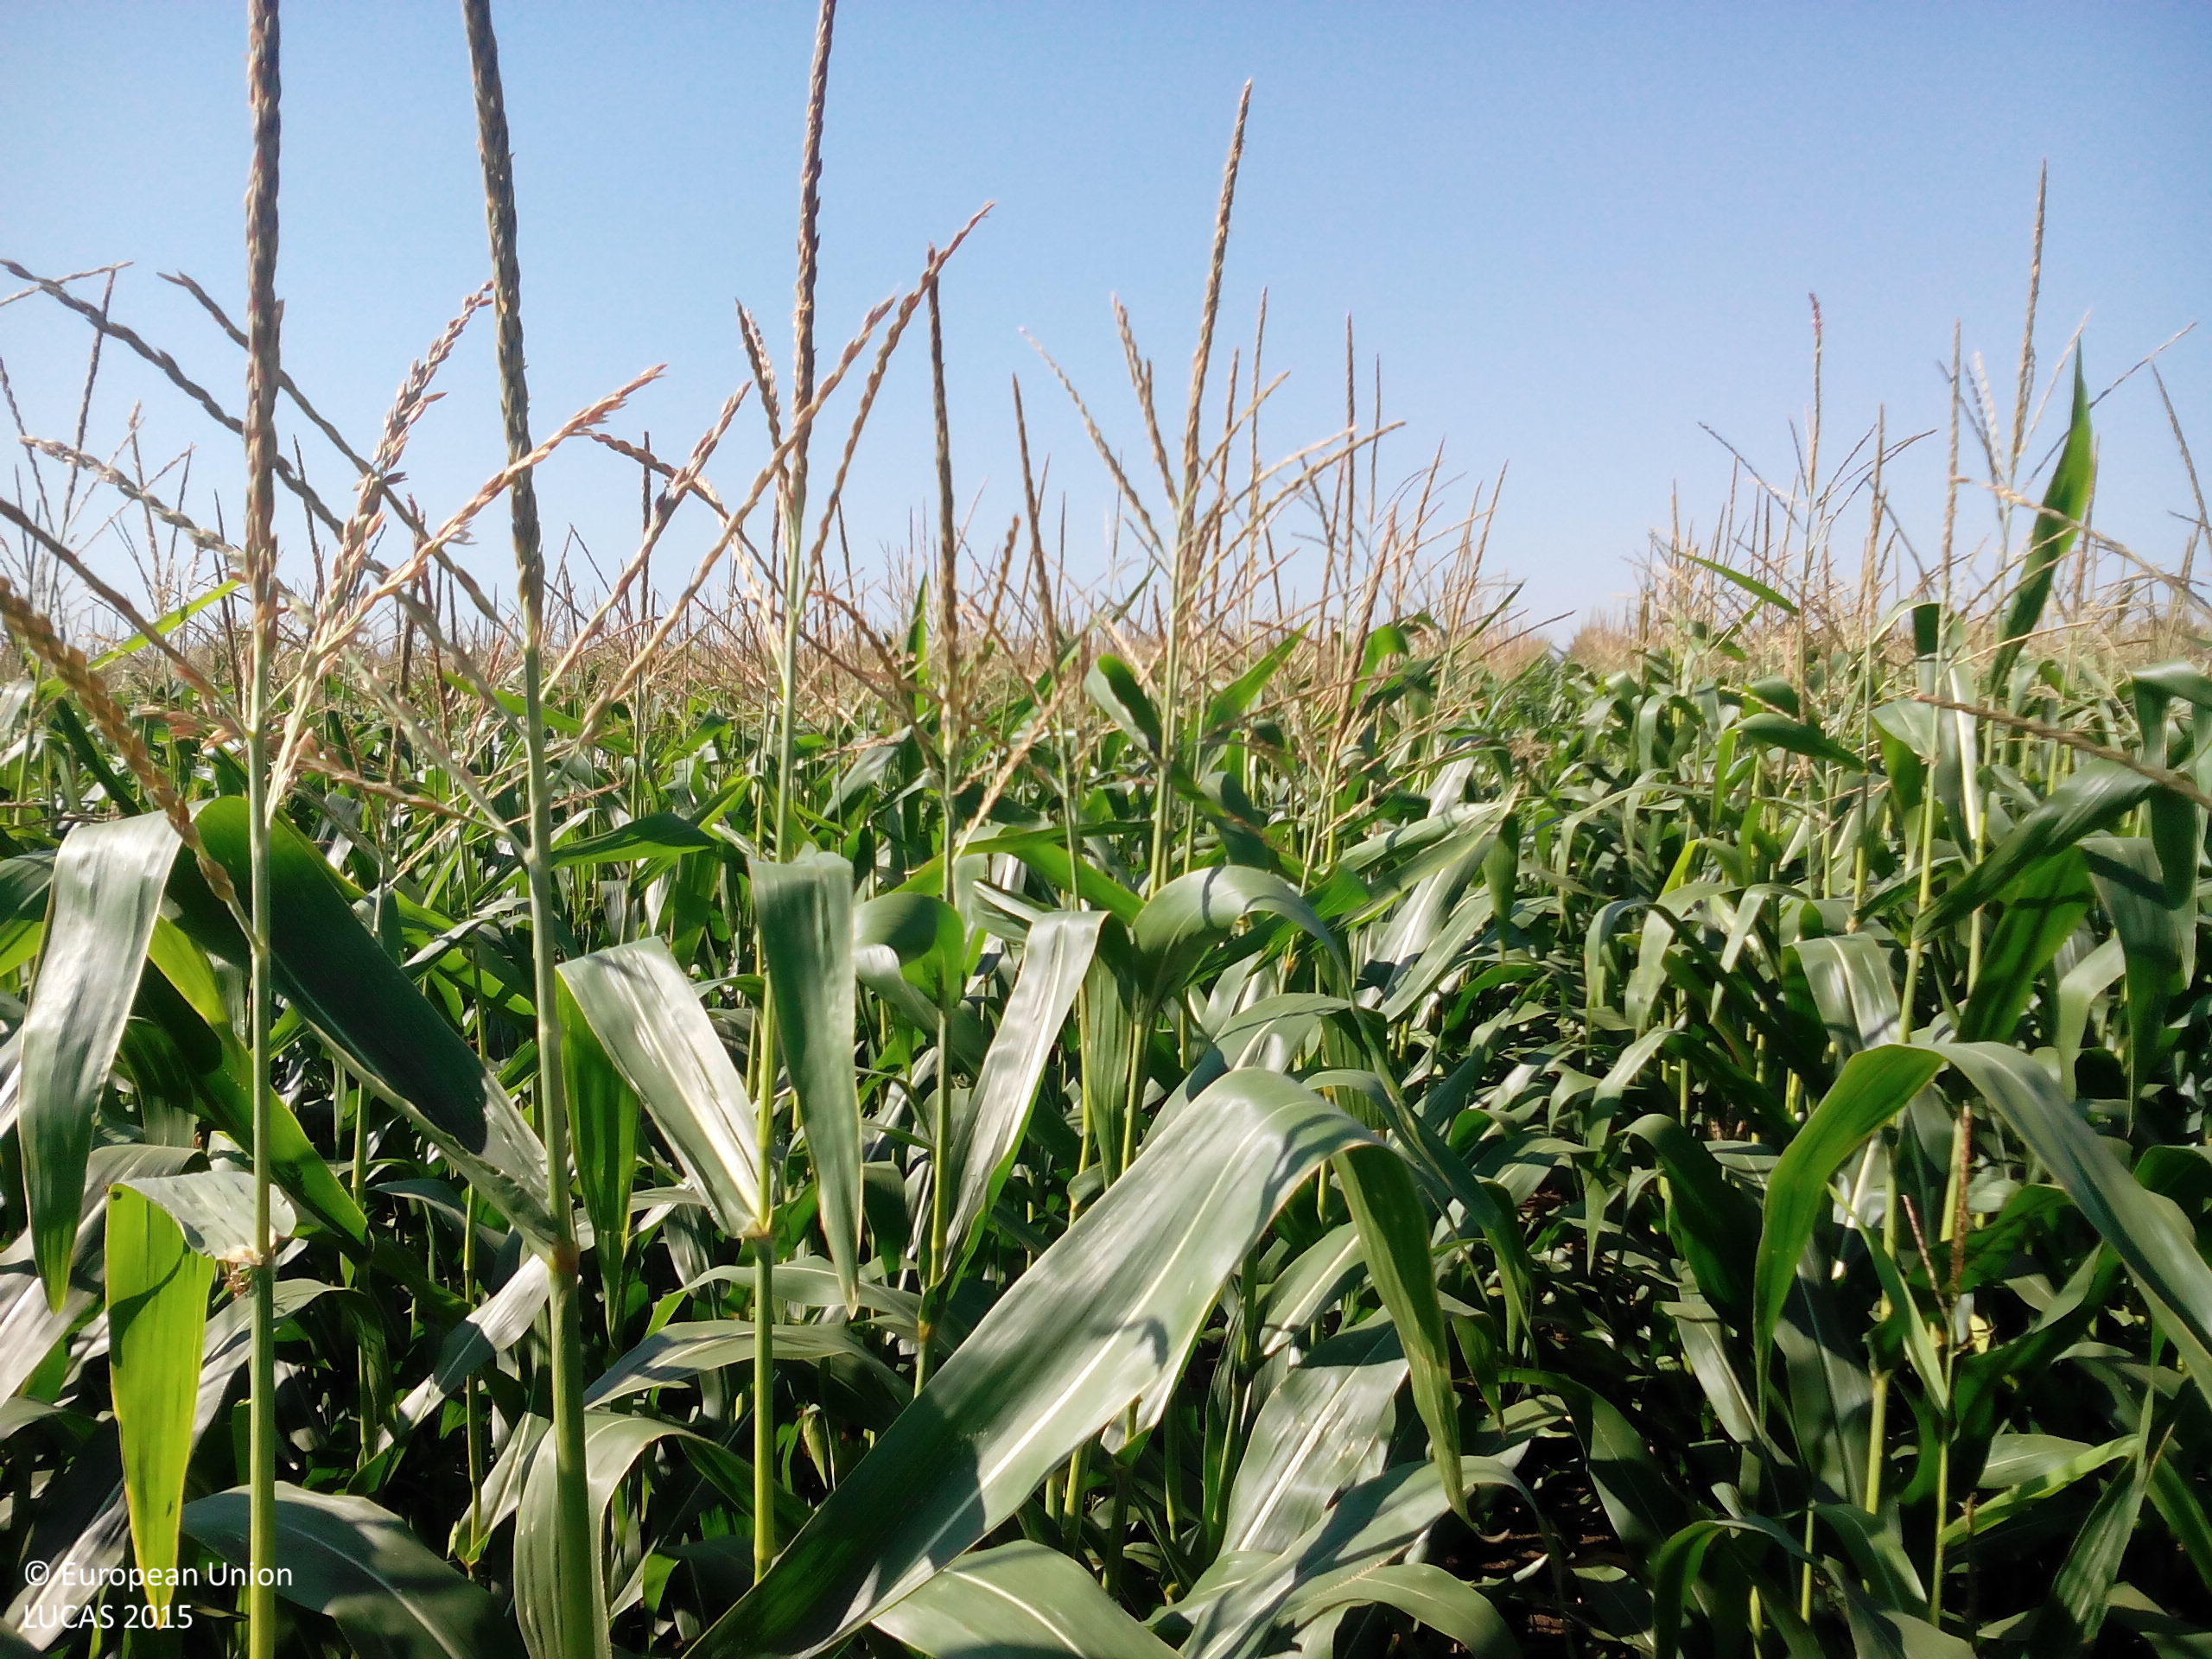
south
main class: Cropland
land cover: Maize
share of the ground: > 75 %
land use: Agriculture (excluding fallow land and kitchen gardens)
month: July
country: BG
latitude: 43.4028
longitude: 24.3441
